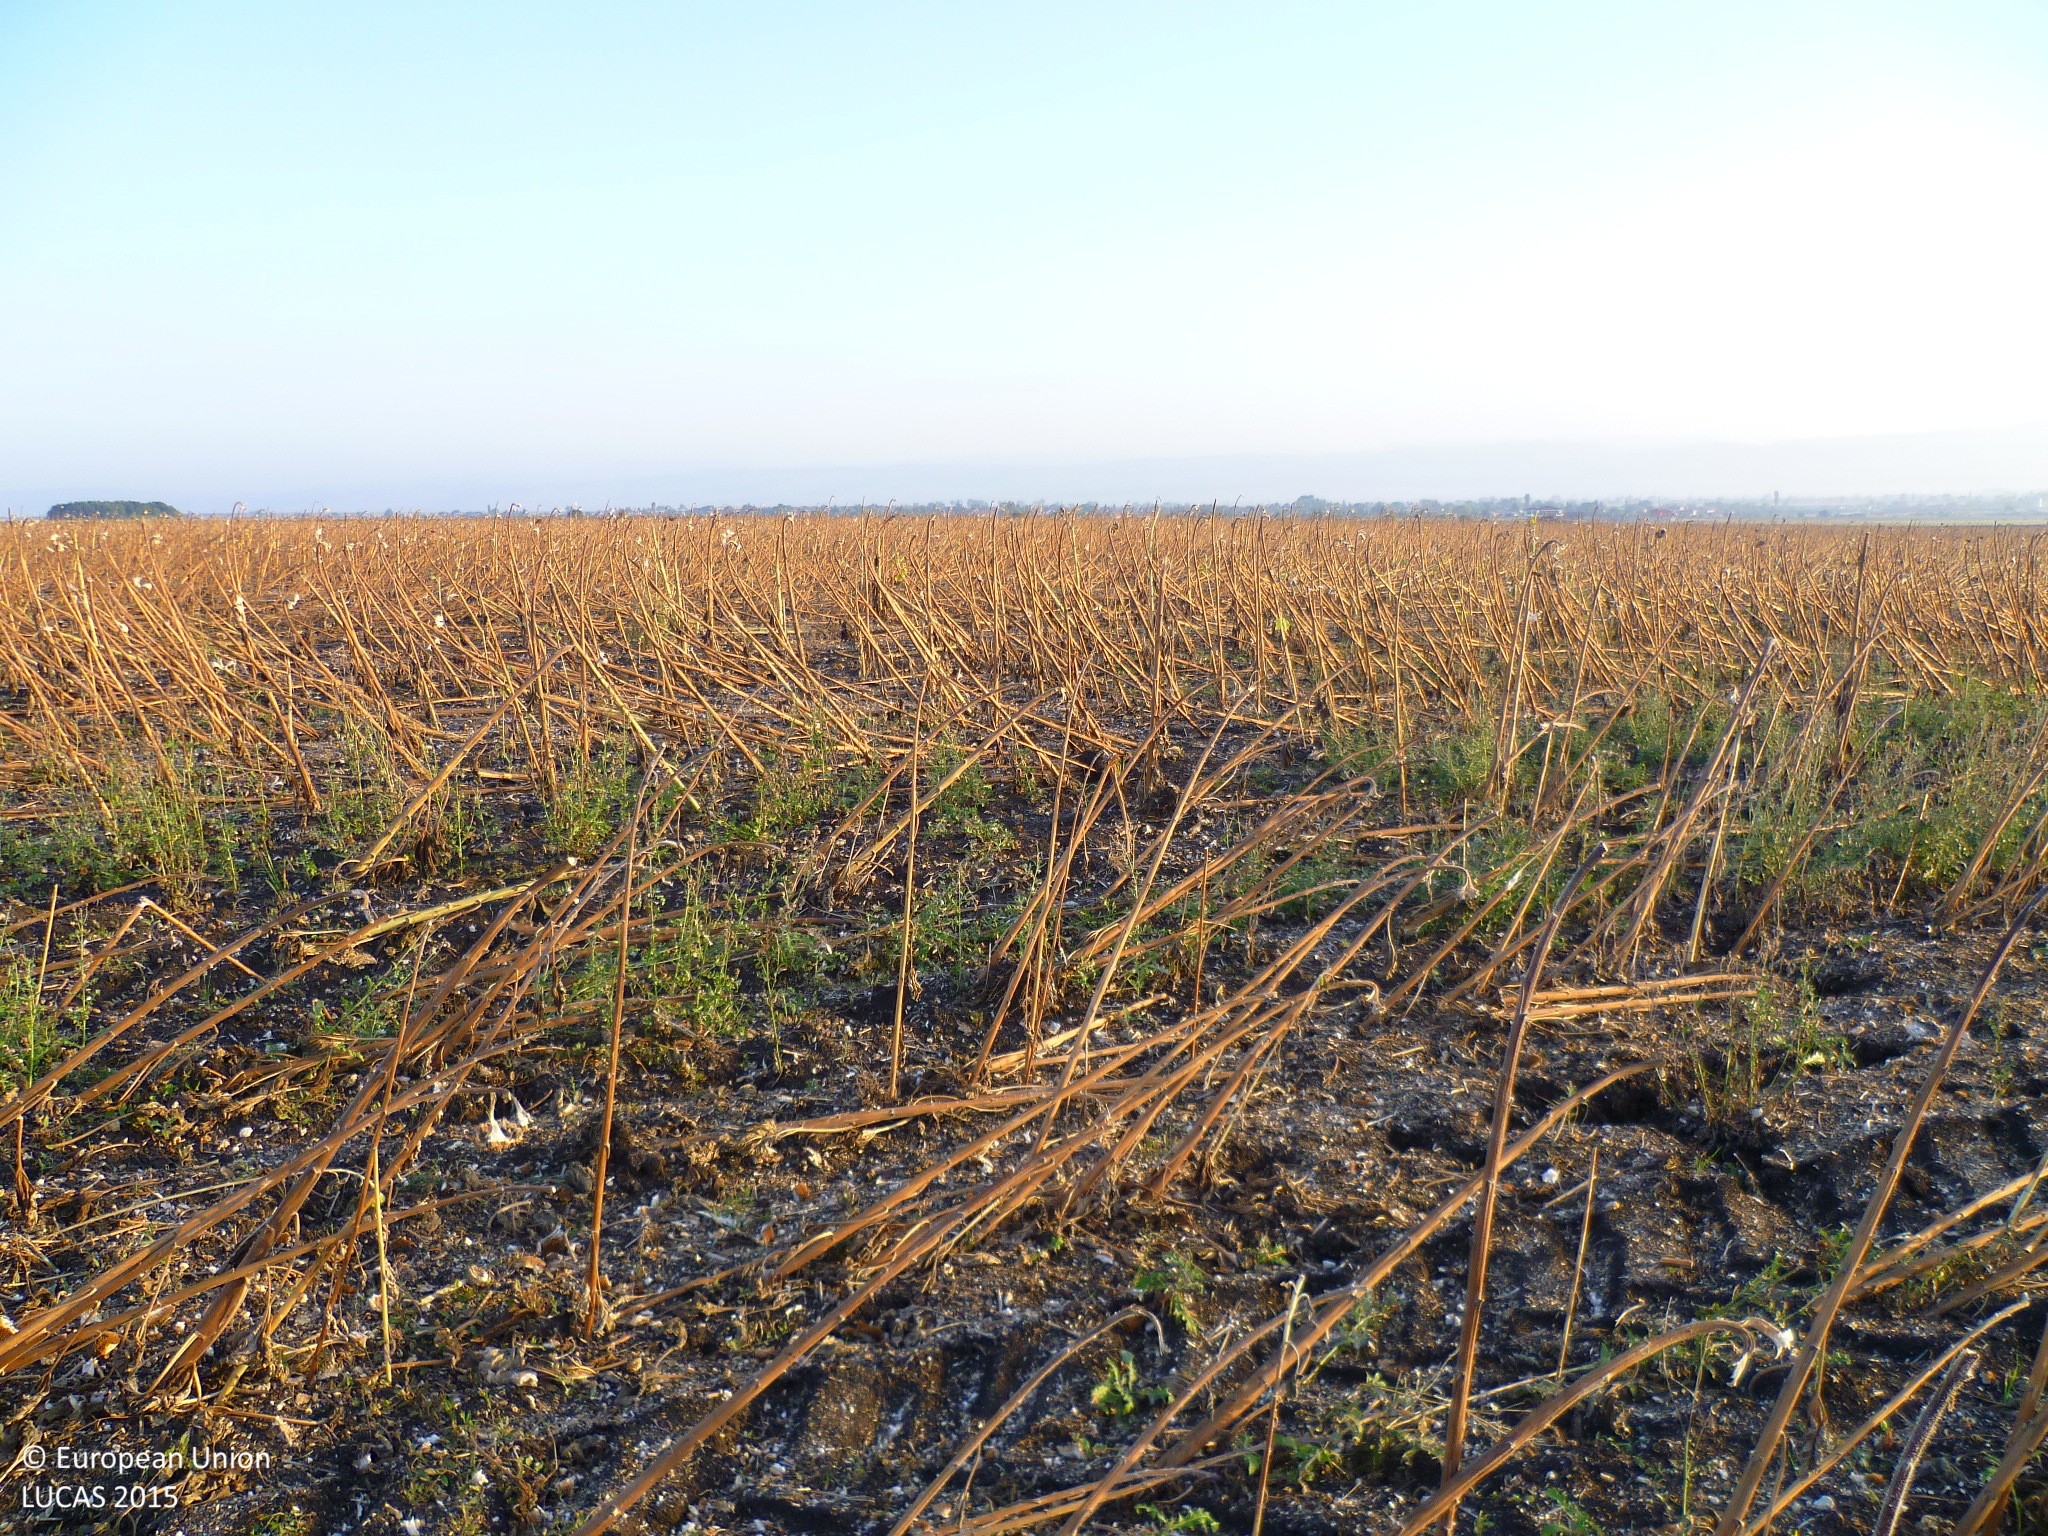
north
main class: Cropland
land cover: Sunflower
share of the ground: 25 - 50 %
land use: Agriculture (excluding fallow land and kitchen gardens)
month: September
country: BG
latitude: 42.7617
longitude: 23.1440
